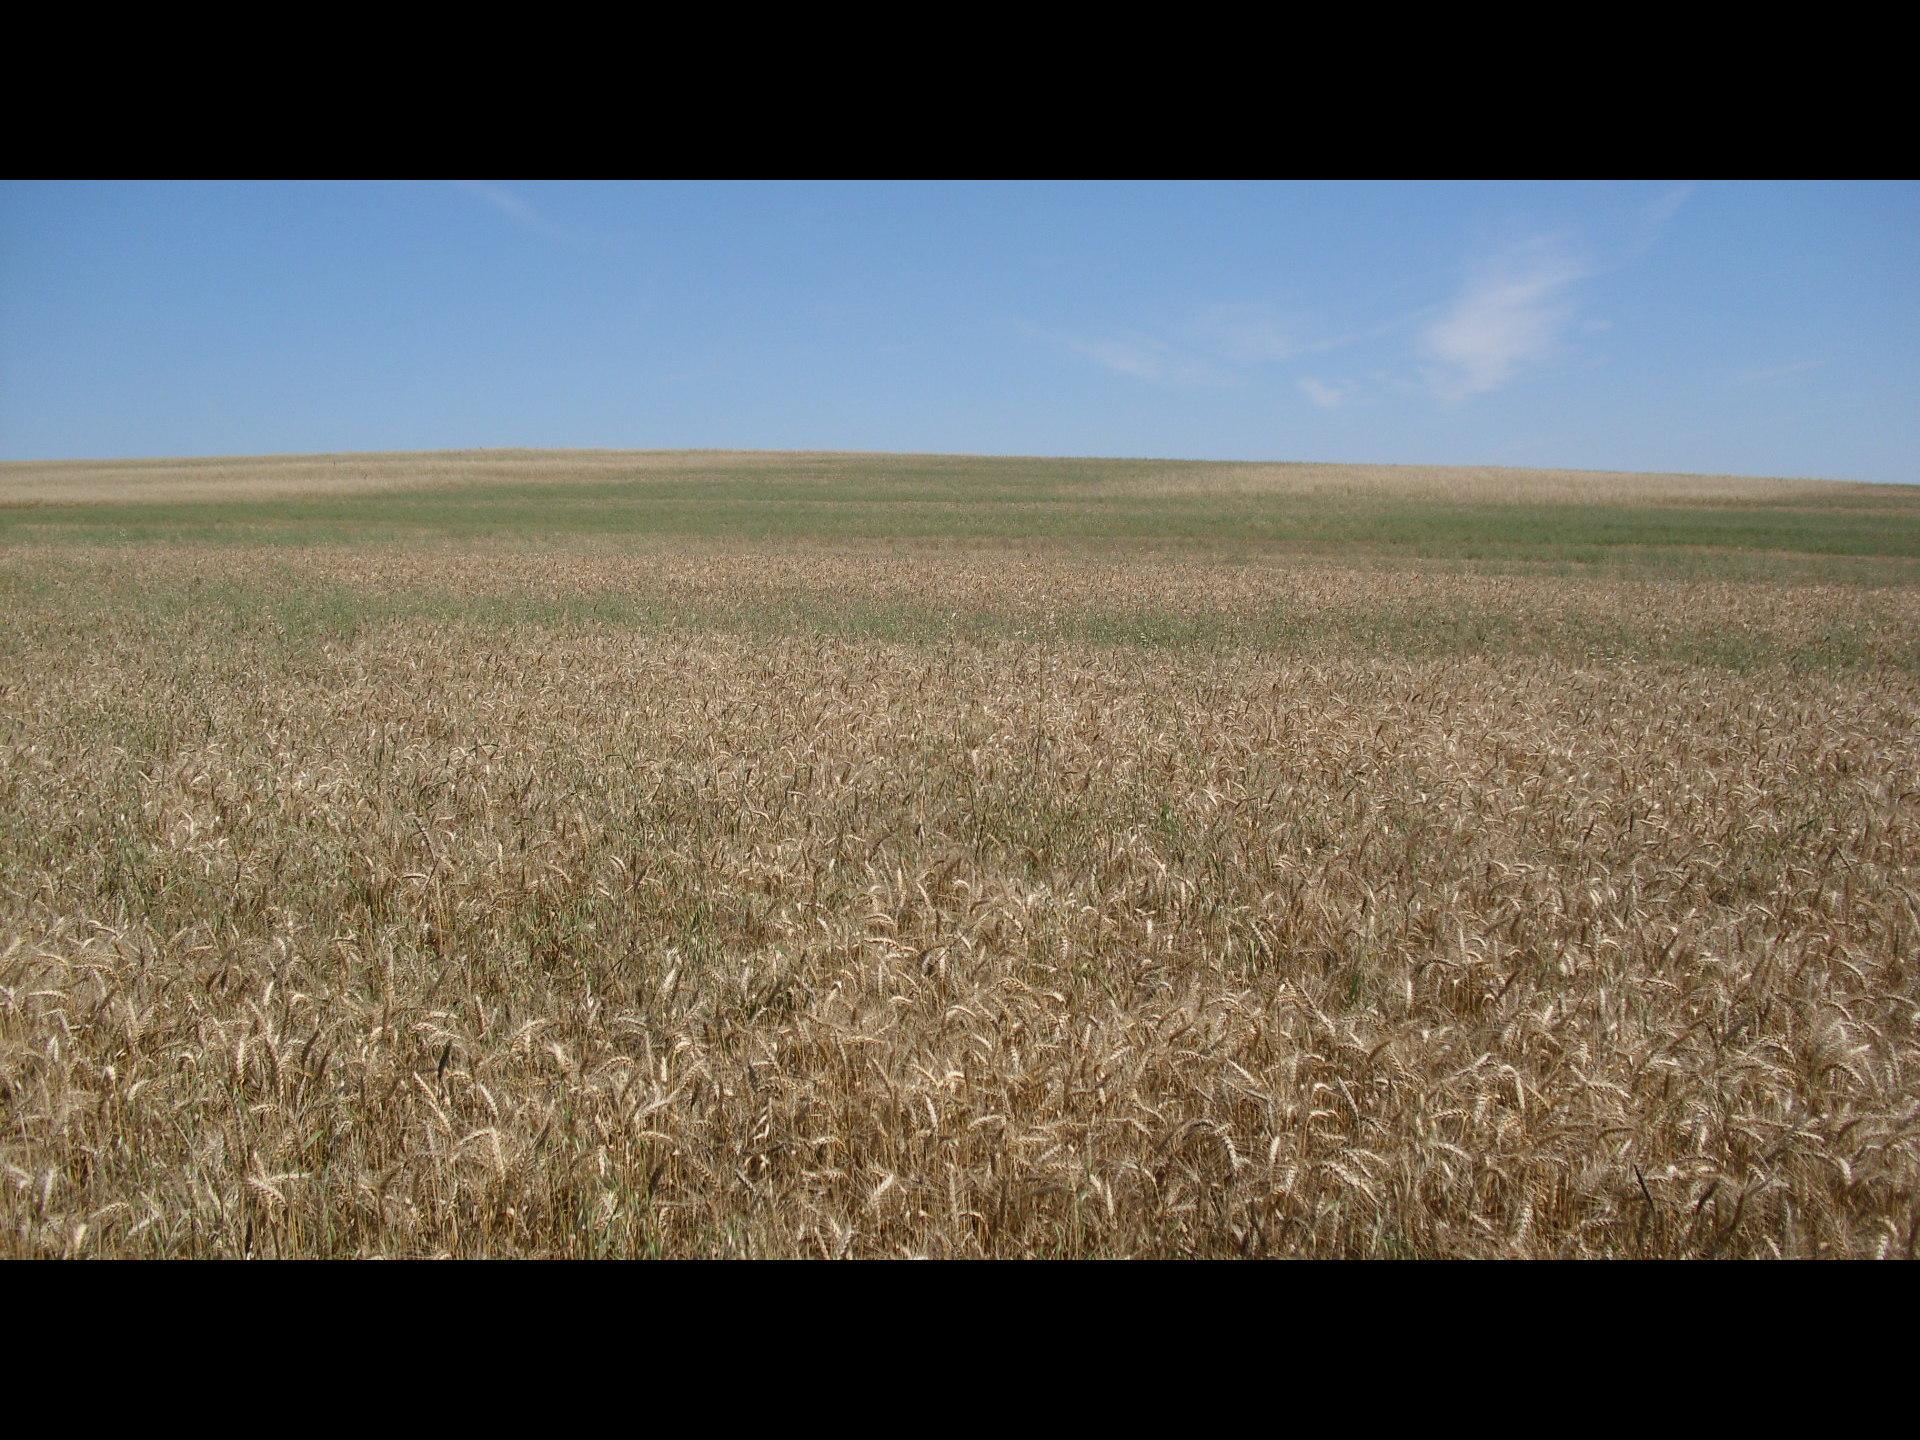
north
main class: Cropland
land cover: Common wheat
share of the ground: > 75 %
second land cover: Oats
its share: 10 - 25 %
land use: Agriculture (excluding fallow land and kitchen gardens)
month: June
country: BG
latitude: 43.4629
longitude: 23.2282
